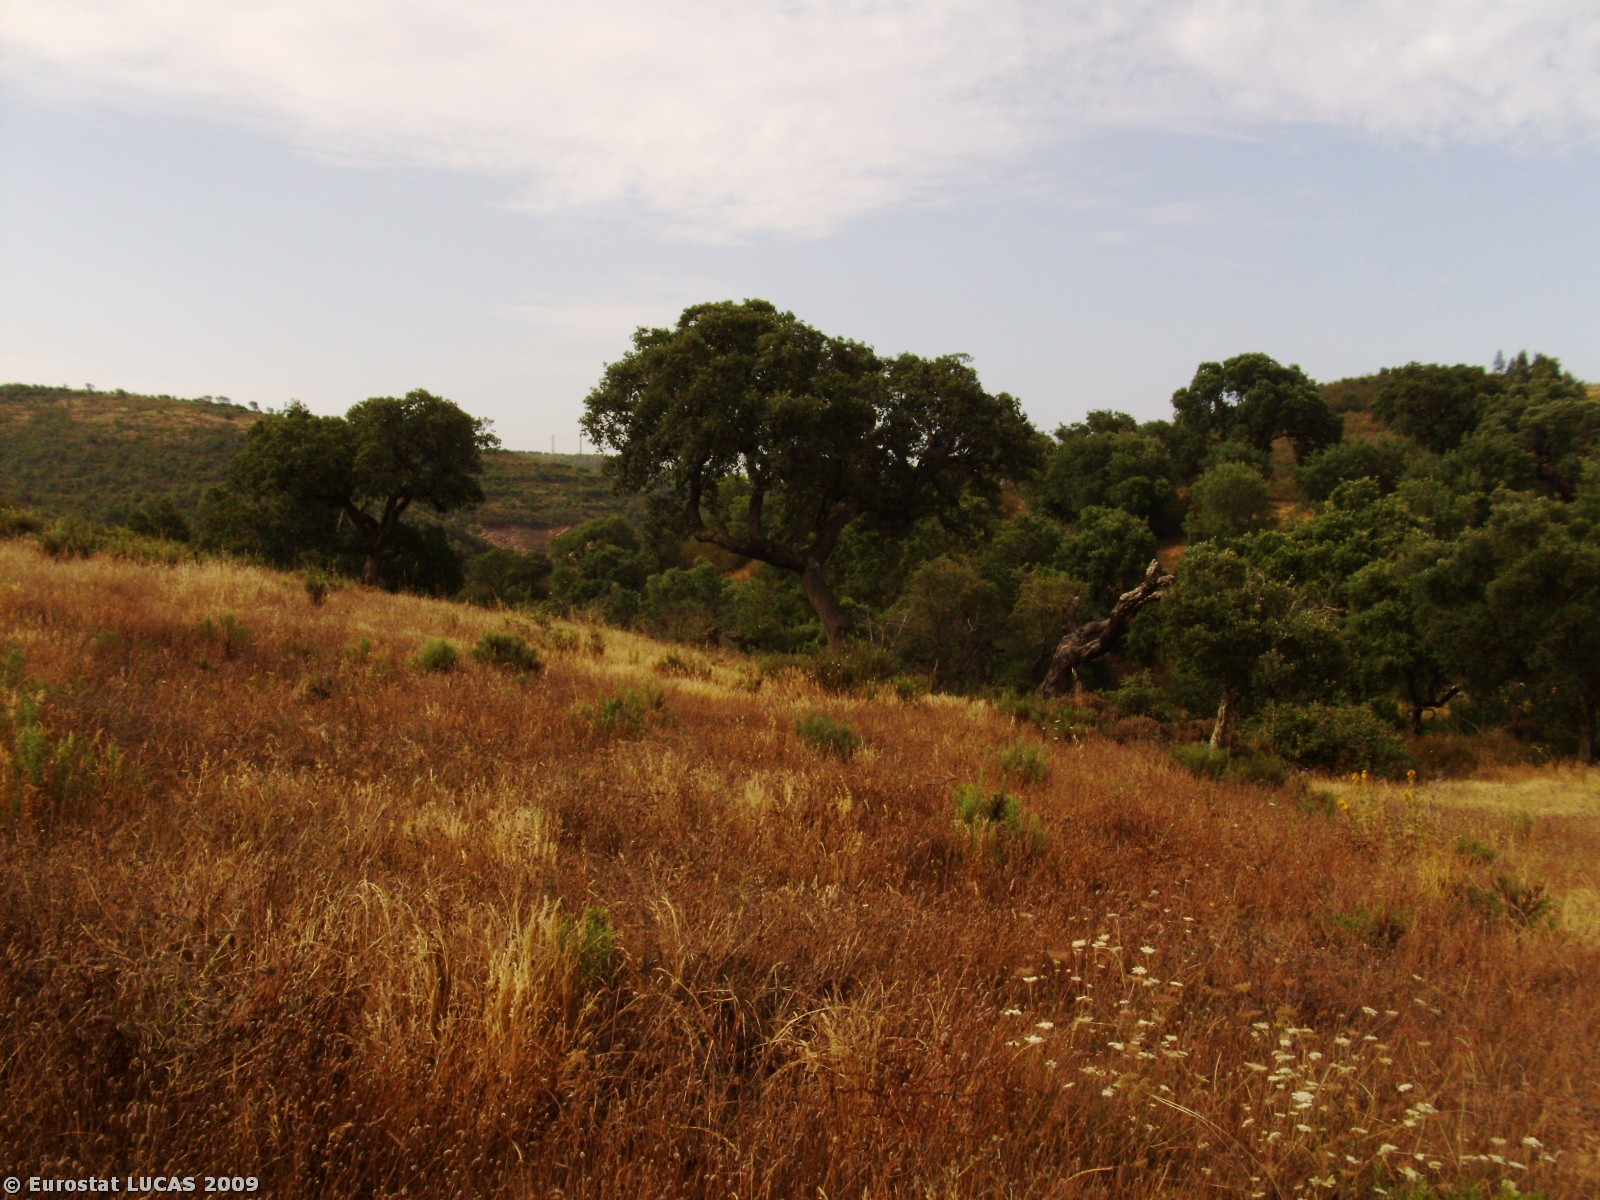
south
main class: Grassland
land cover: Spontaneously vegetated surfaces
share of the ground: > 75 %
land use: Fallow land
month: June
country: PT
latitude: 37.3411
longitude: -8.7850
